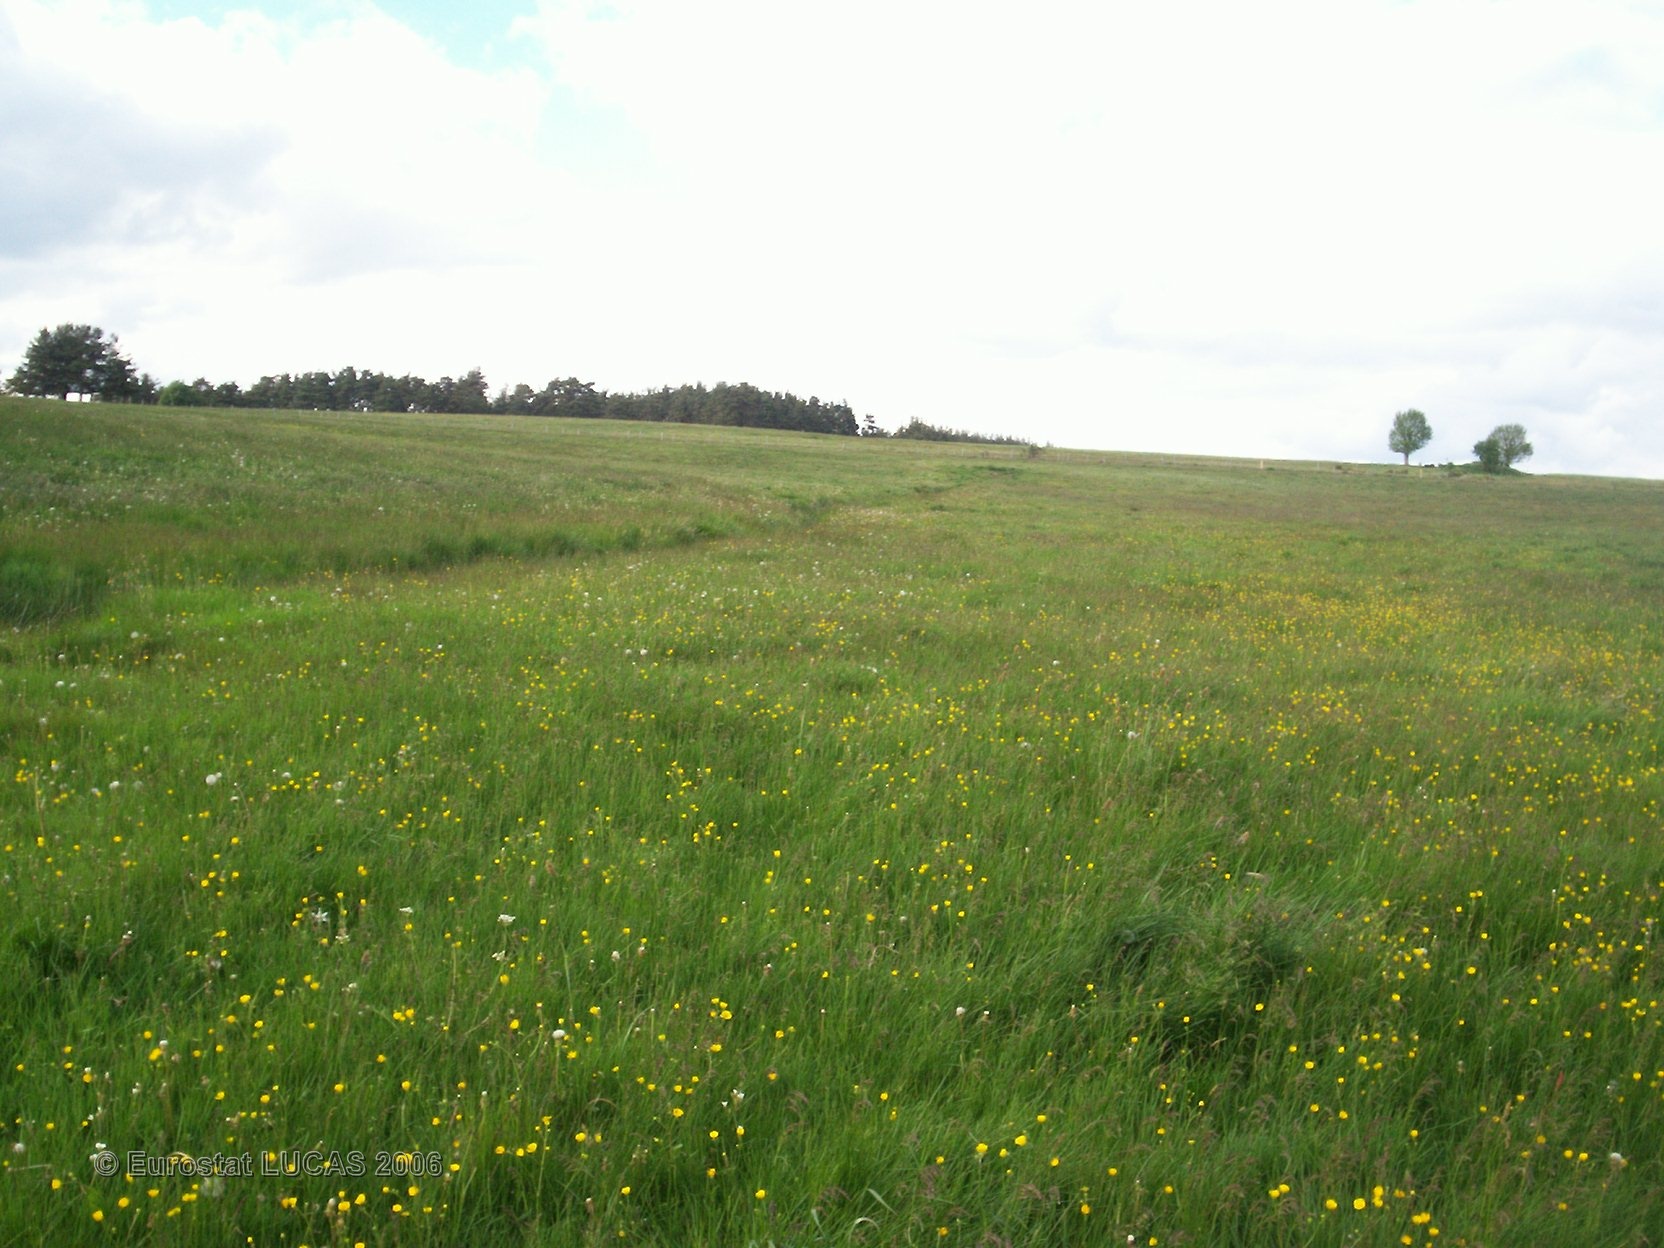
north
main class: Grassland
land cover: Grassland without tree/shrub cover
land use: Agriculture (excluding fallow land and kitchen gardens)
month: May
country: FR
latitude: 44.7013
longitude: 3.4038
